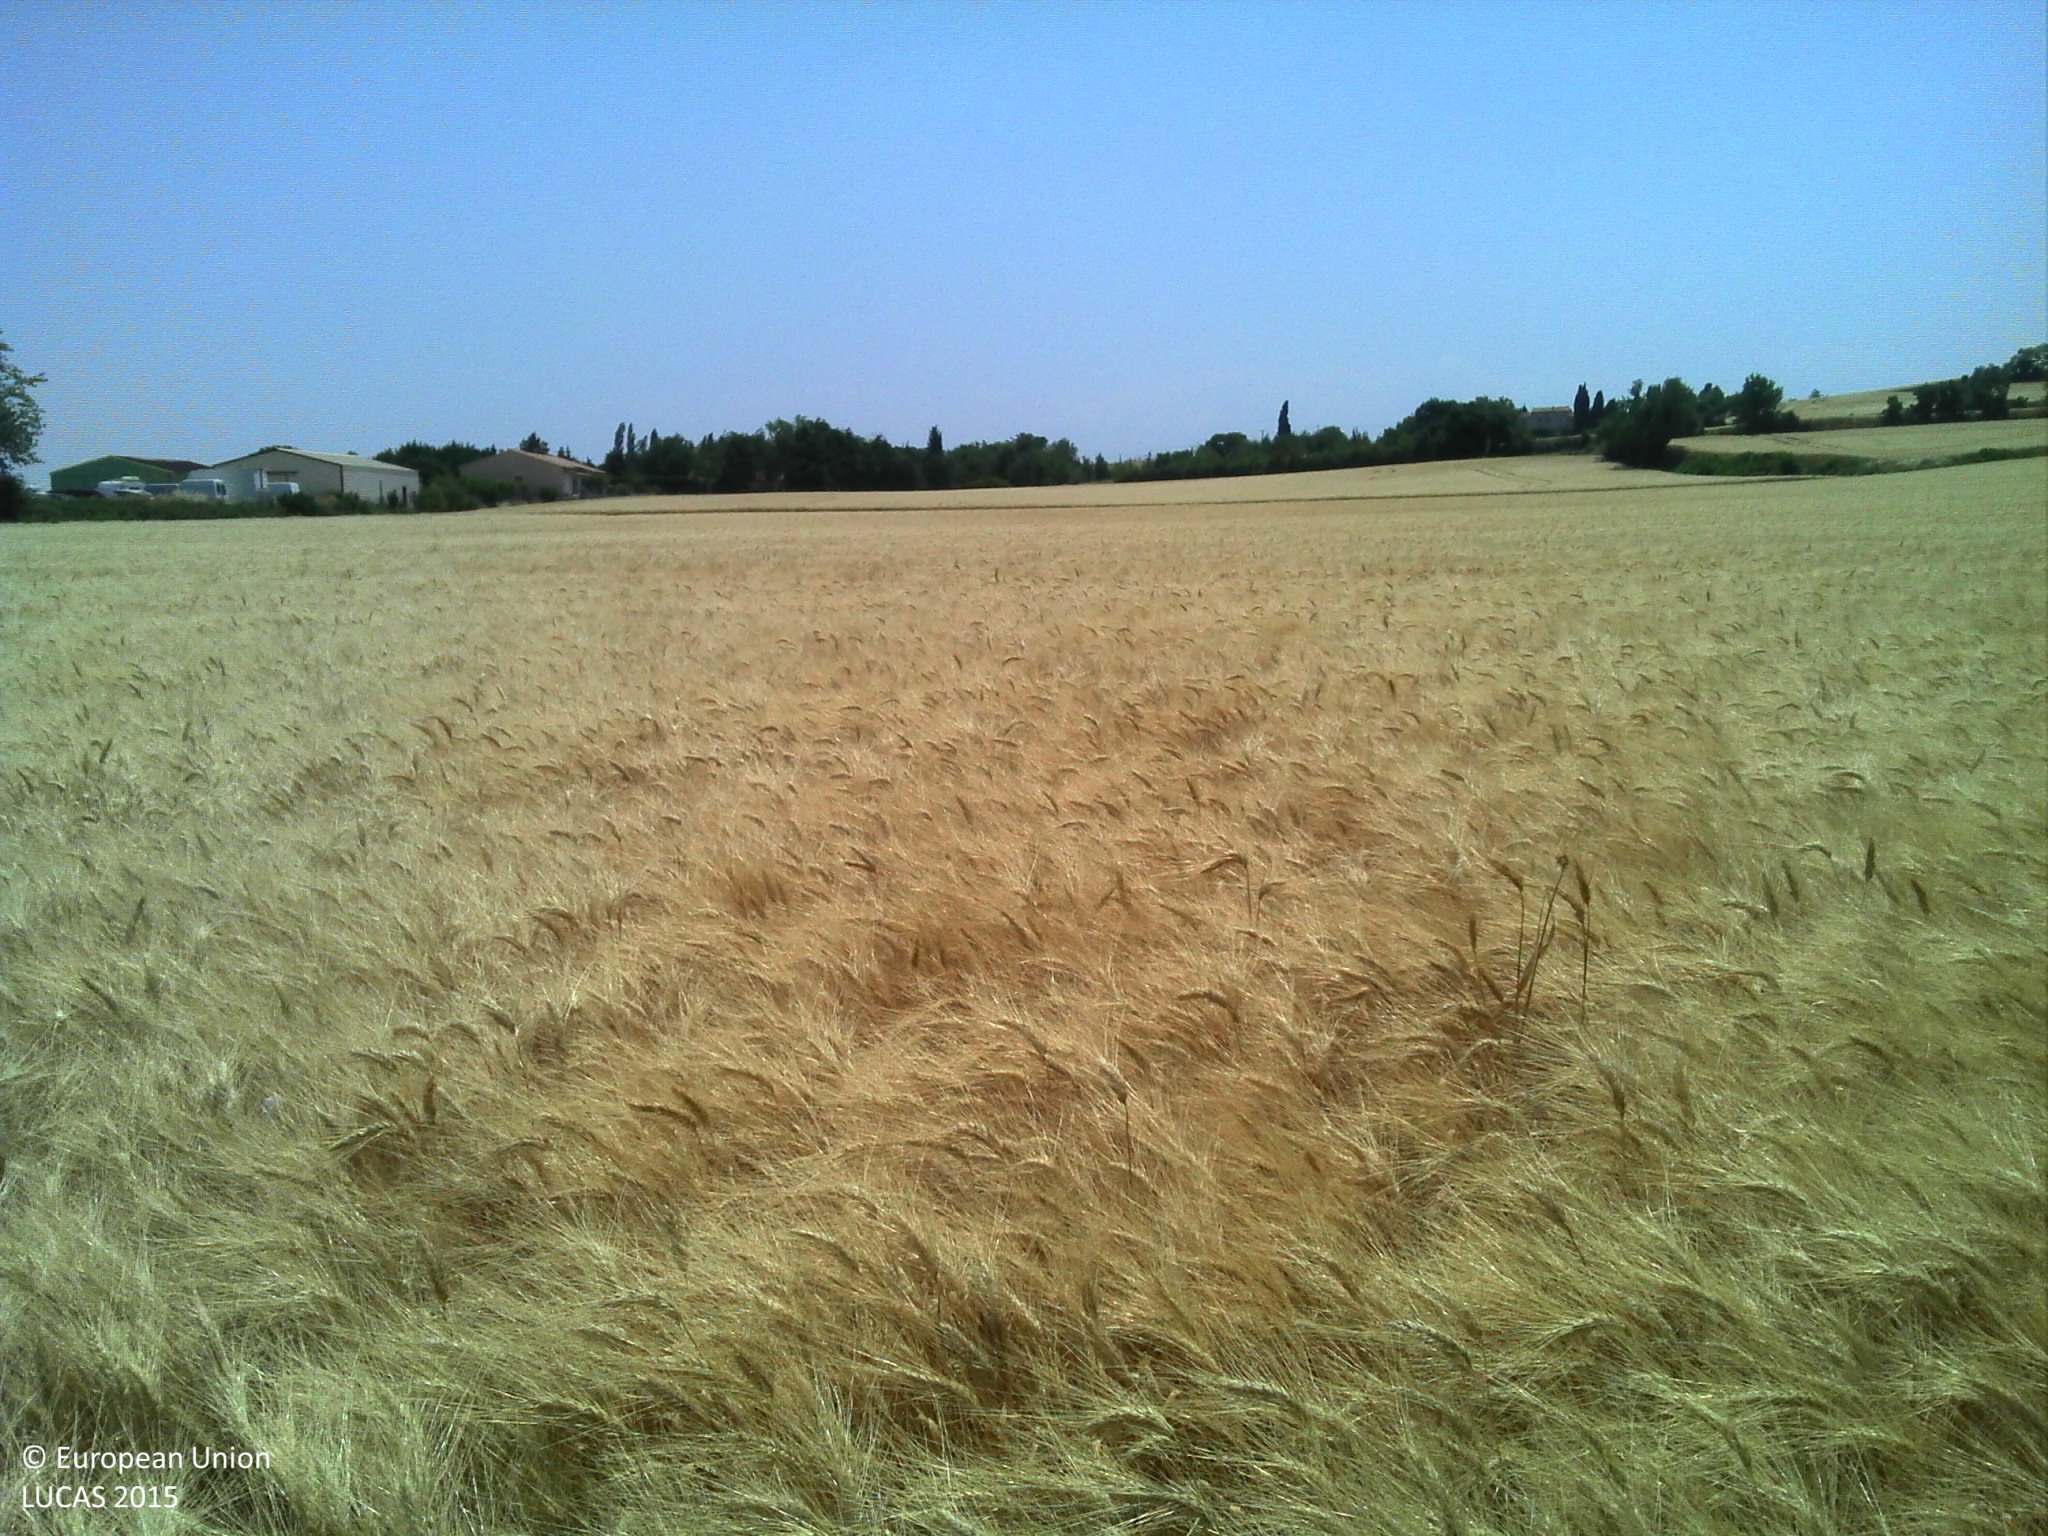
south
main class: Cropland
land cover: Durum wheat
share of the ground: > 75 %
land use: Agriculture (excluding fallow land and kitchen gardens)
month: June
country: FR
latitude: 43.2111
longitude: 2.0432
